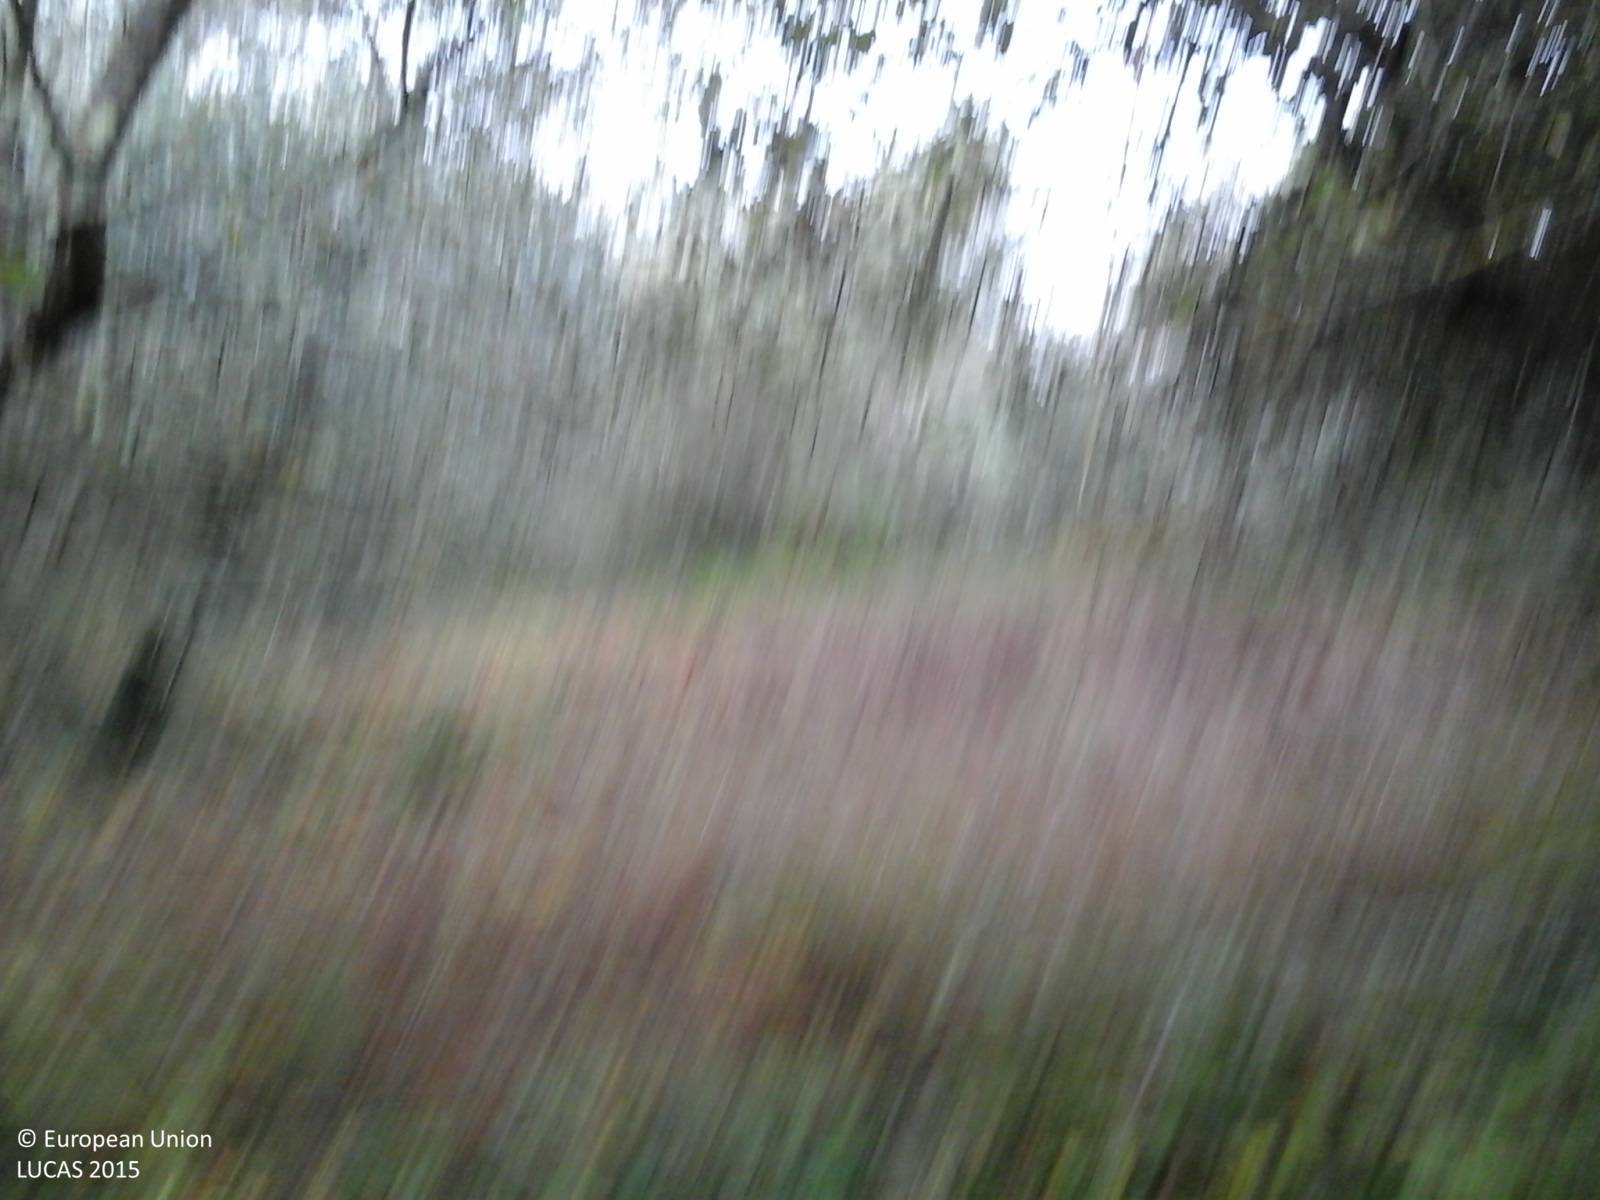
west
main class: Cropland
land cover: Olive groves
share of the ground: 50 - 75 %
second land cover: Shrubland without tree cover
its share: > 75 %
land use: Abandoned areas
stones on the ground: 10 - 25 %
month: October
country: IT
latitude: 43.0652
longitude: 10.9181
